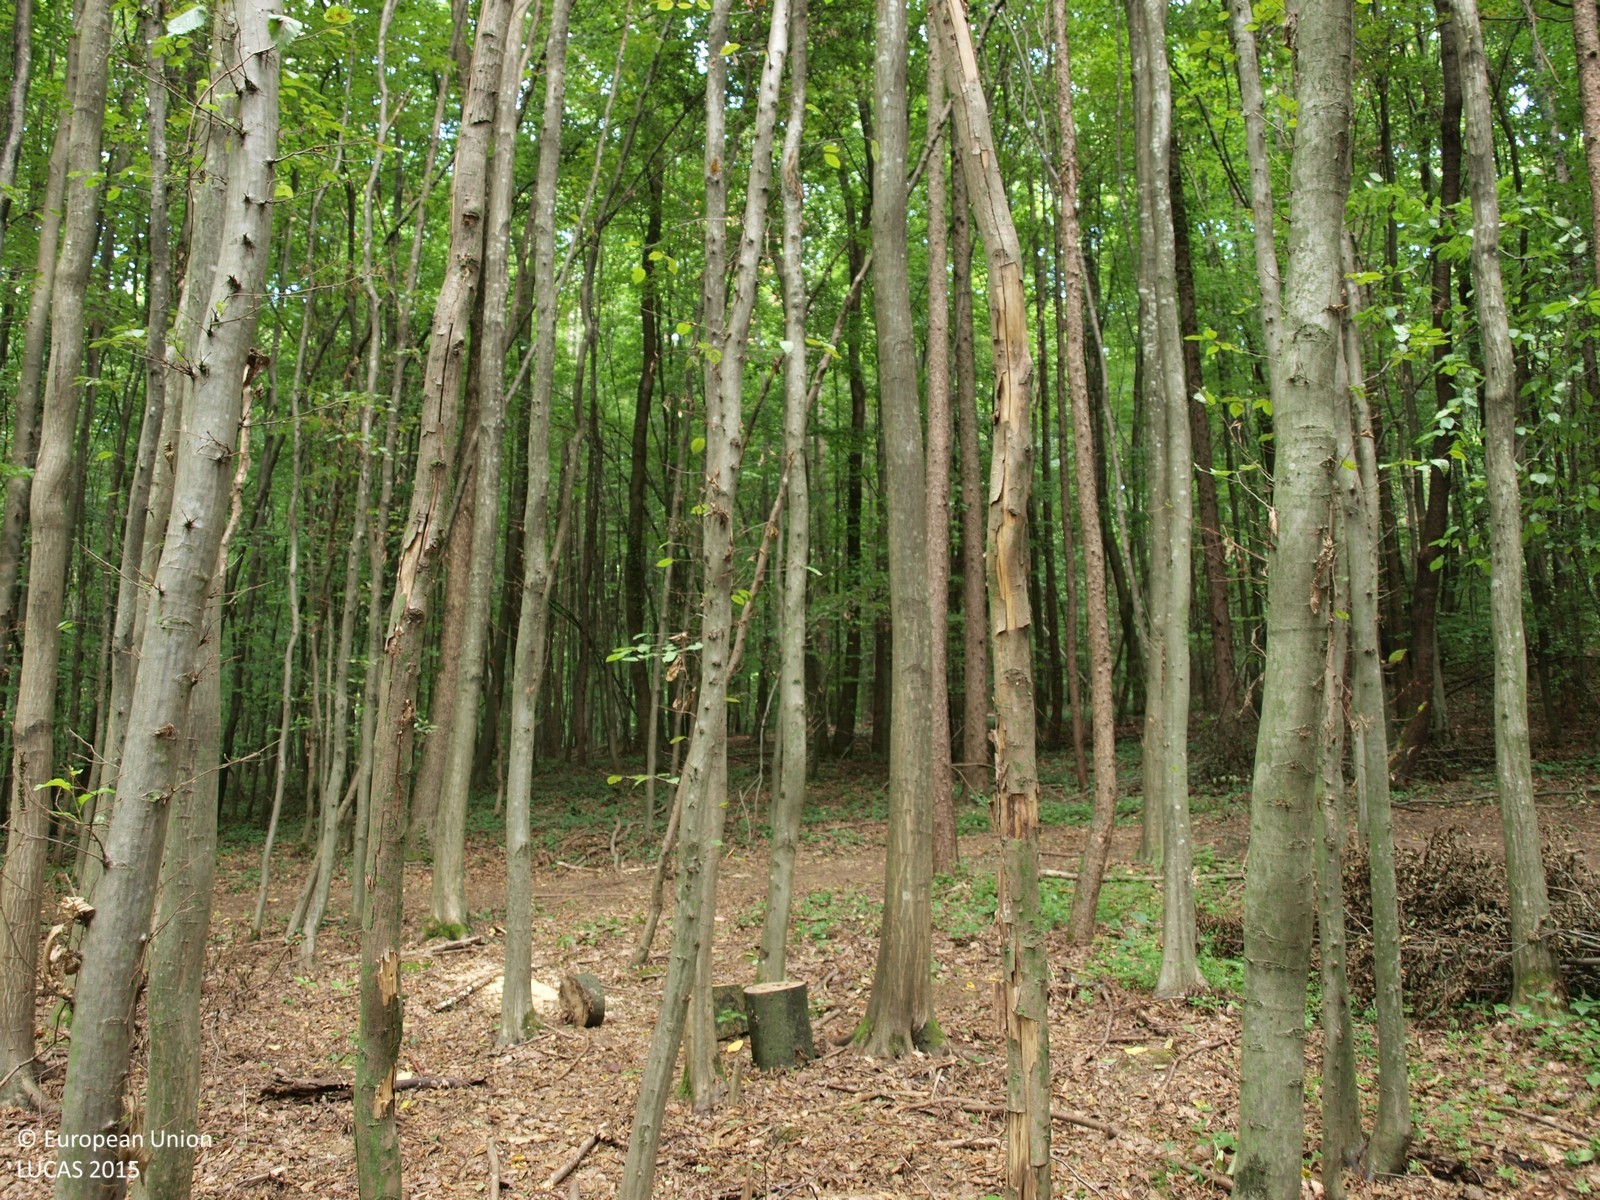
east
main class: Woodland
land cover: Broadleaved woodland
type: beech forest
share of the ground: > 75 %
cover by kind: broadleaved forest trees 100 %
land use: Forestry
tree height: > 5 m
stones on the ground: < 10 %
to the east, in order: Broadleaved woodland
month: August
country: HR
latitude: 46.0028
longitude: 16.5986
